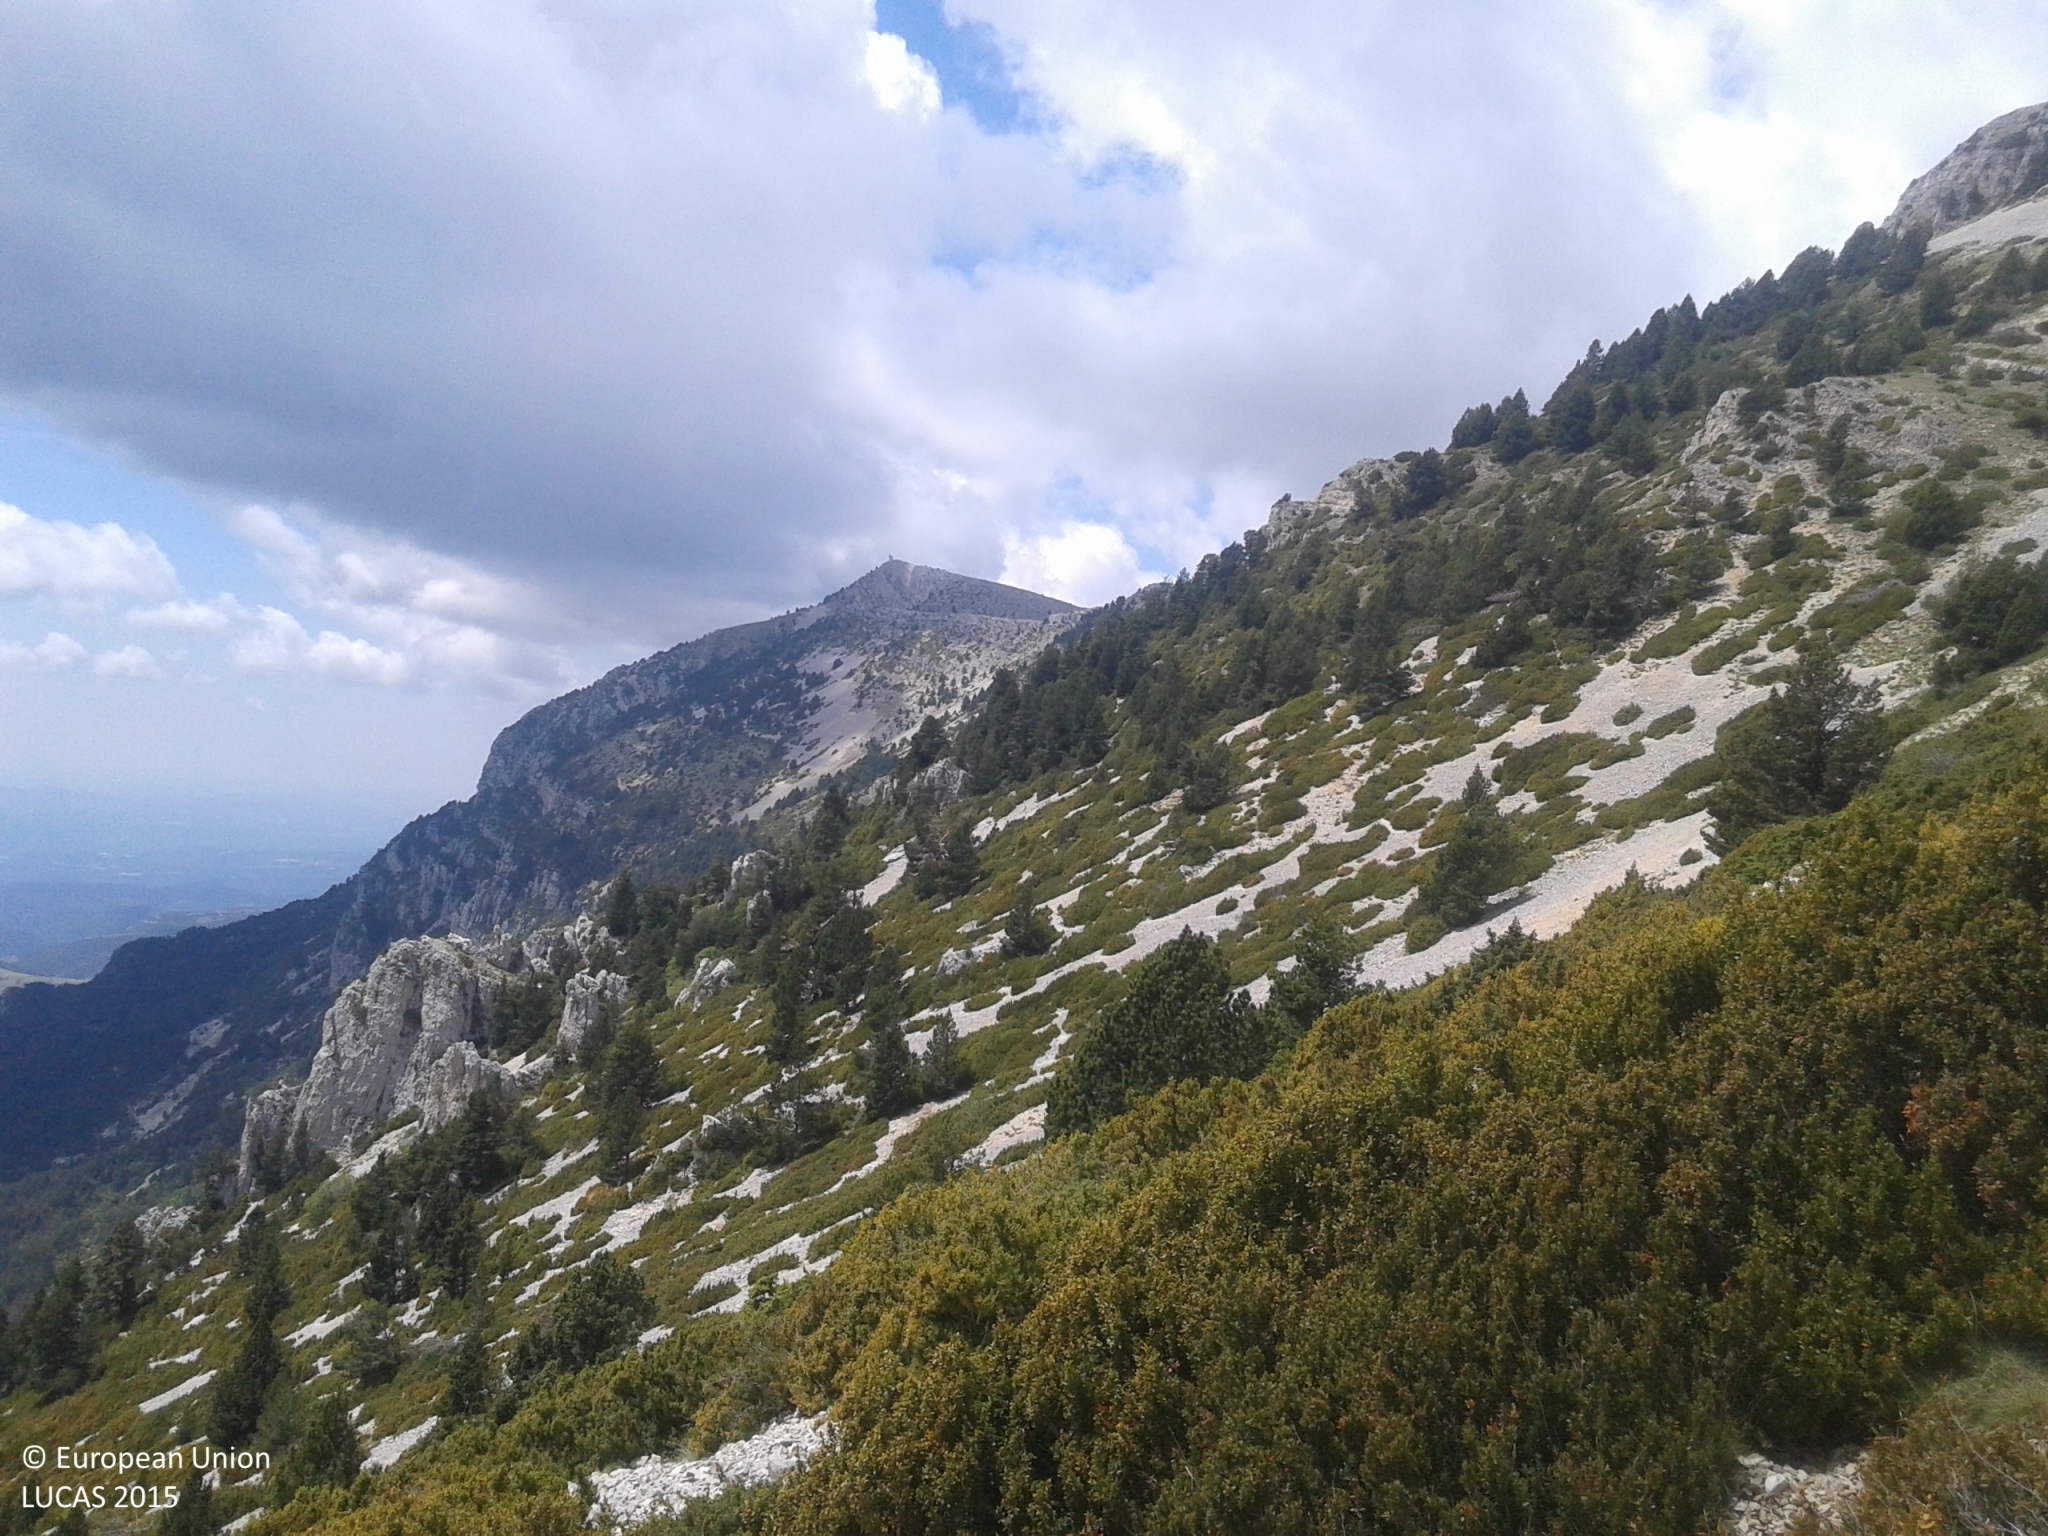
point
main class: Woodland
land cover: Pine dominated coniferous woodland
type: alpine coniferous forest
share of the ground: 10 - 25 %
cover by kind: unconsolidated bare surface 80 %, coniferous forest trees 15 %, shrubs 5 %
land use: Semi-natural and natural areas not in use
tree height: > 5 m
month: May
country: ES
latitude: 42.1554
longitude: 1.5521
